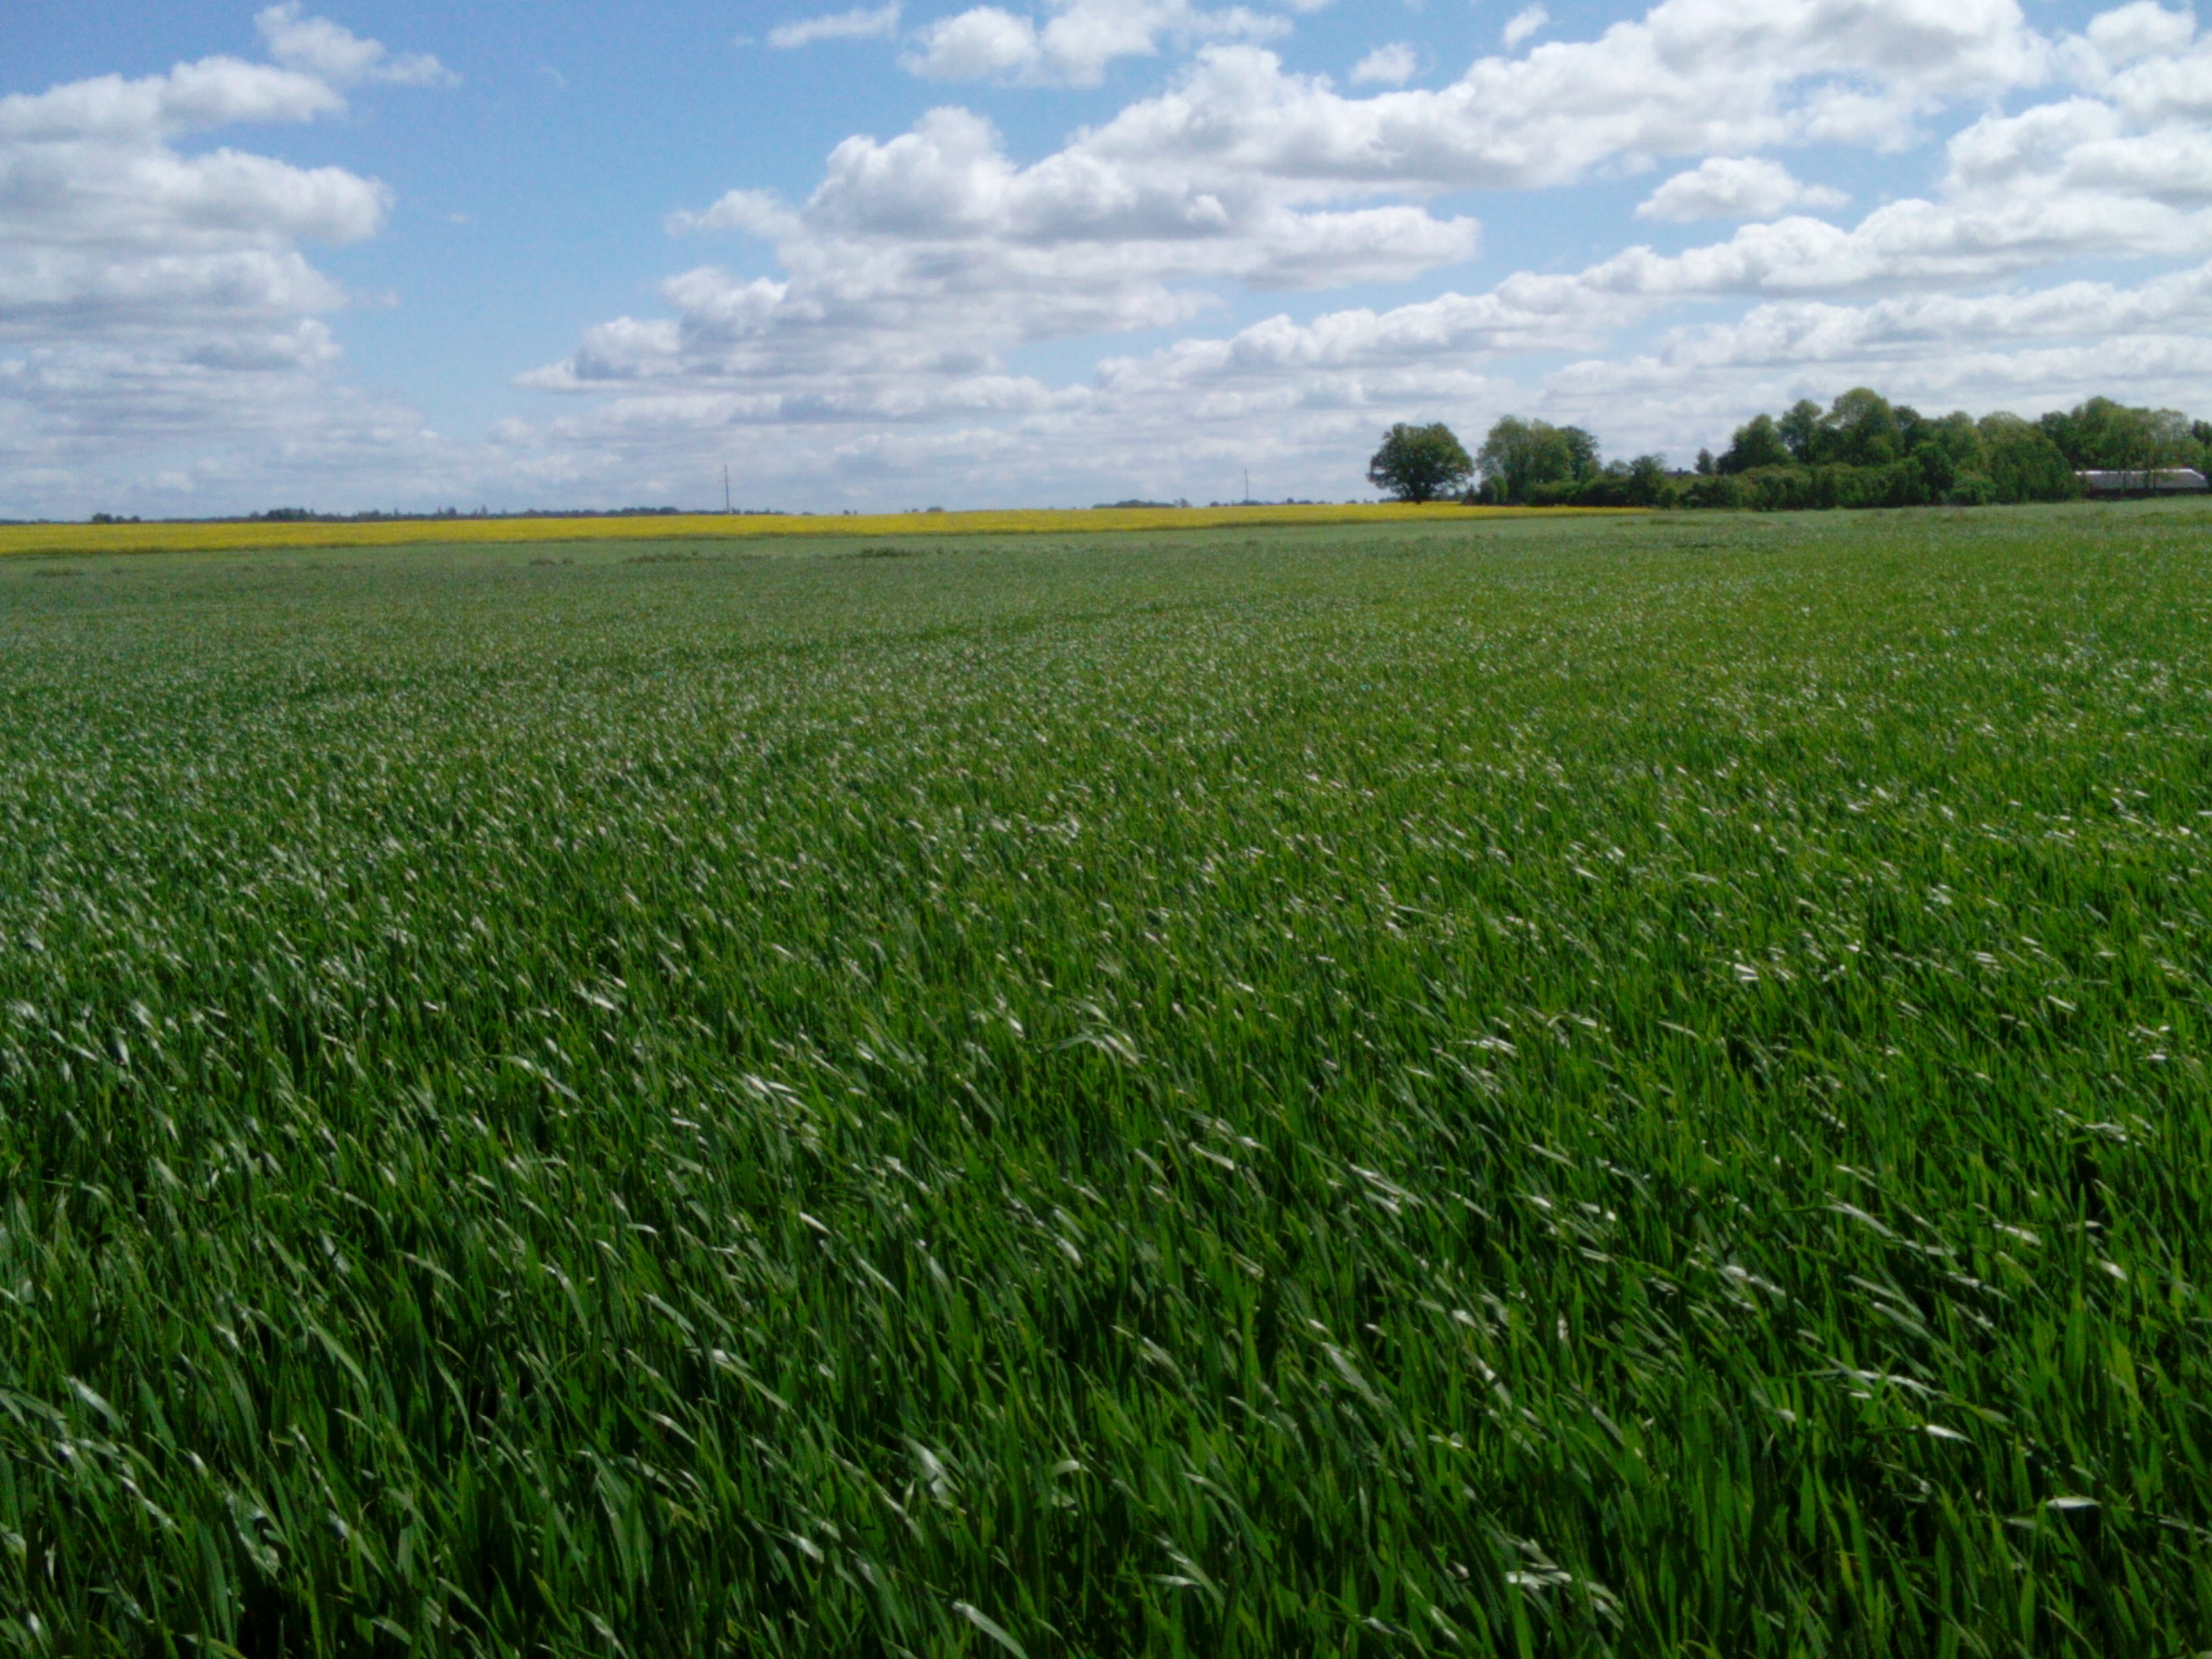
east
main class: Cropland
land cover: Barley
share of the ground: > 75 %
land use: Agriculture (excluding fallow land and kitchen gardens)
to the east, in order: Barley; Grass margins; Ditches and canals; Grass margins; Barley
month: June
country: LV
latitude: 56.7524
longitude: 22.3688
